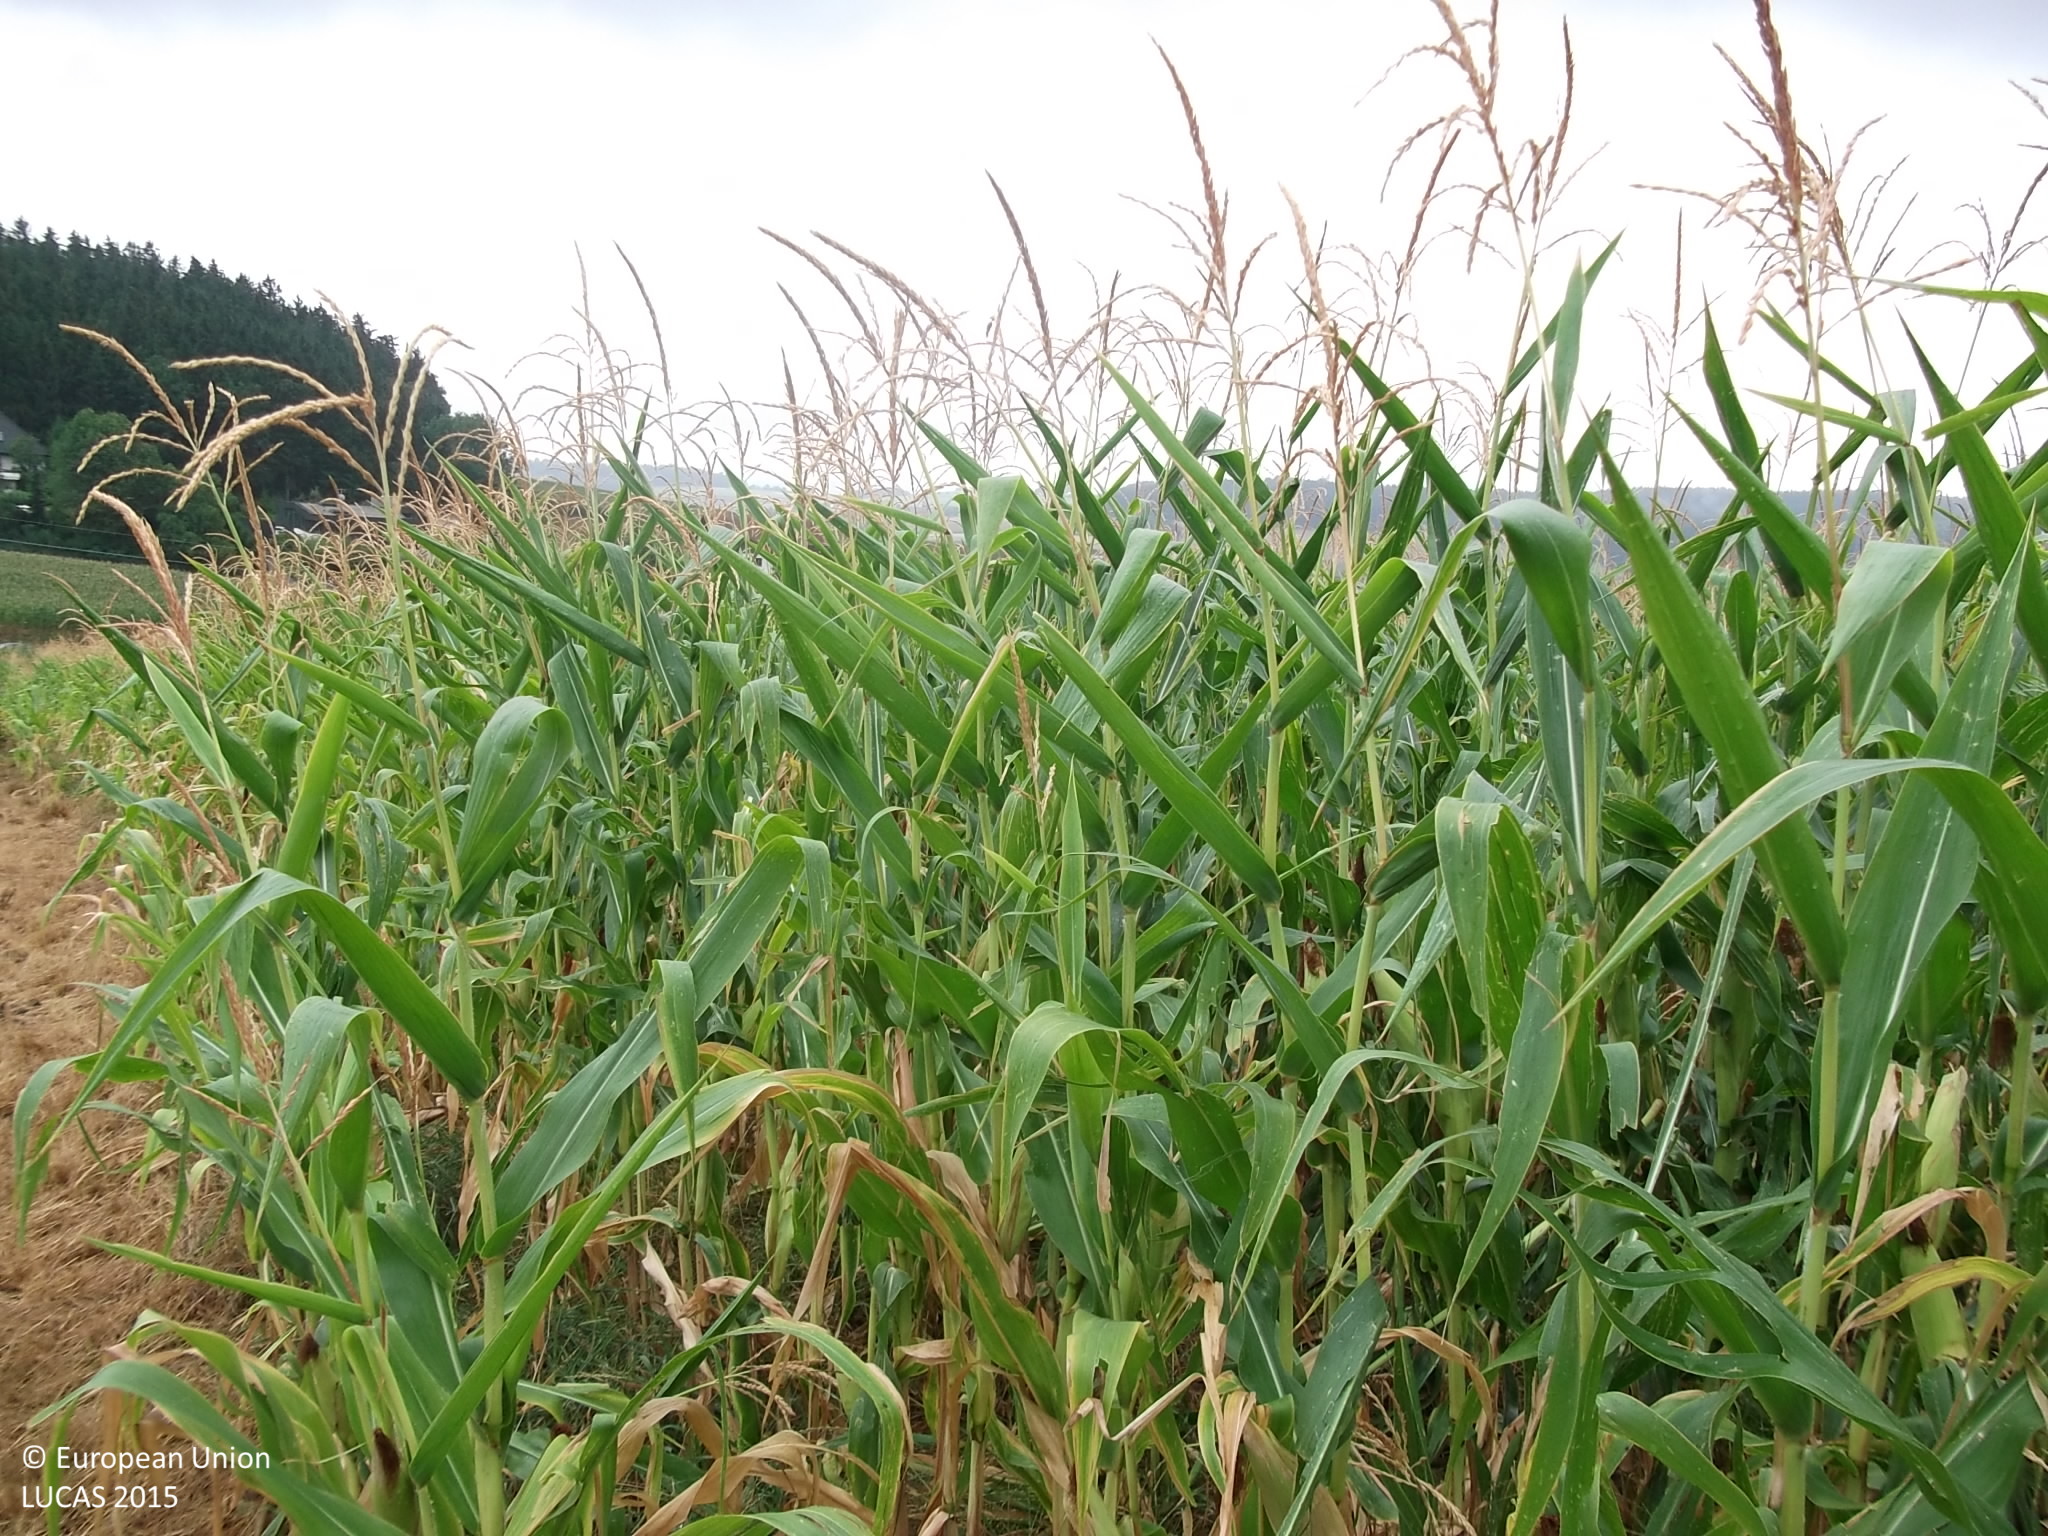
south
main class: Cropland
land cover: Maize
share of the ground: > 75 %
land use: Agriculture (excluding fallow land and kitchen gardens)
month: August
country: AT
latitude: 48.2446
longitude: 13.3523
